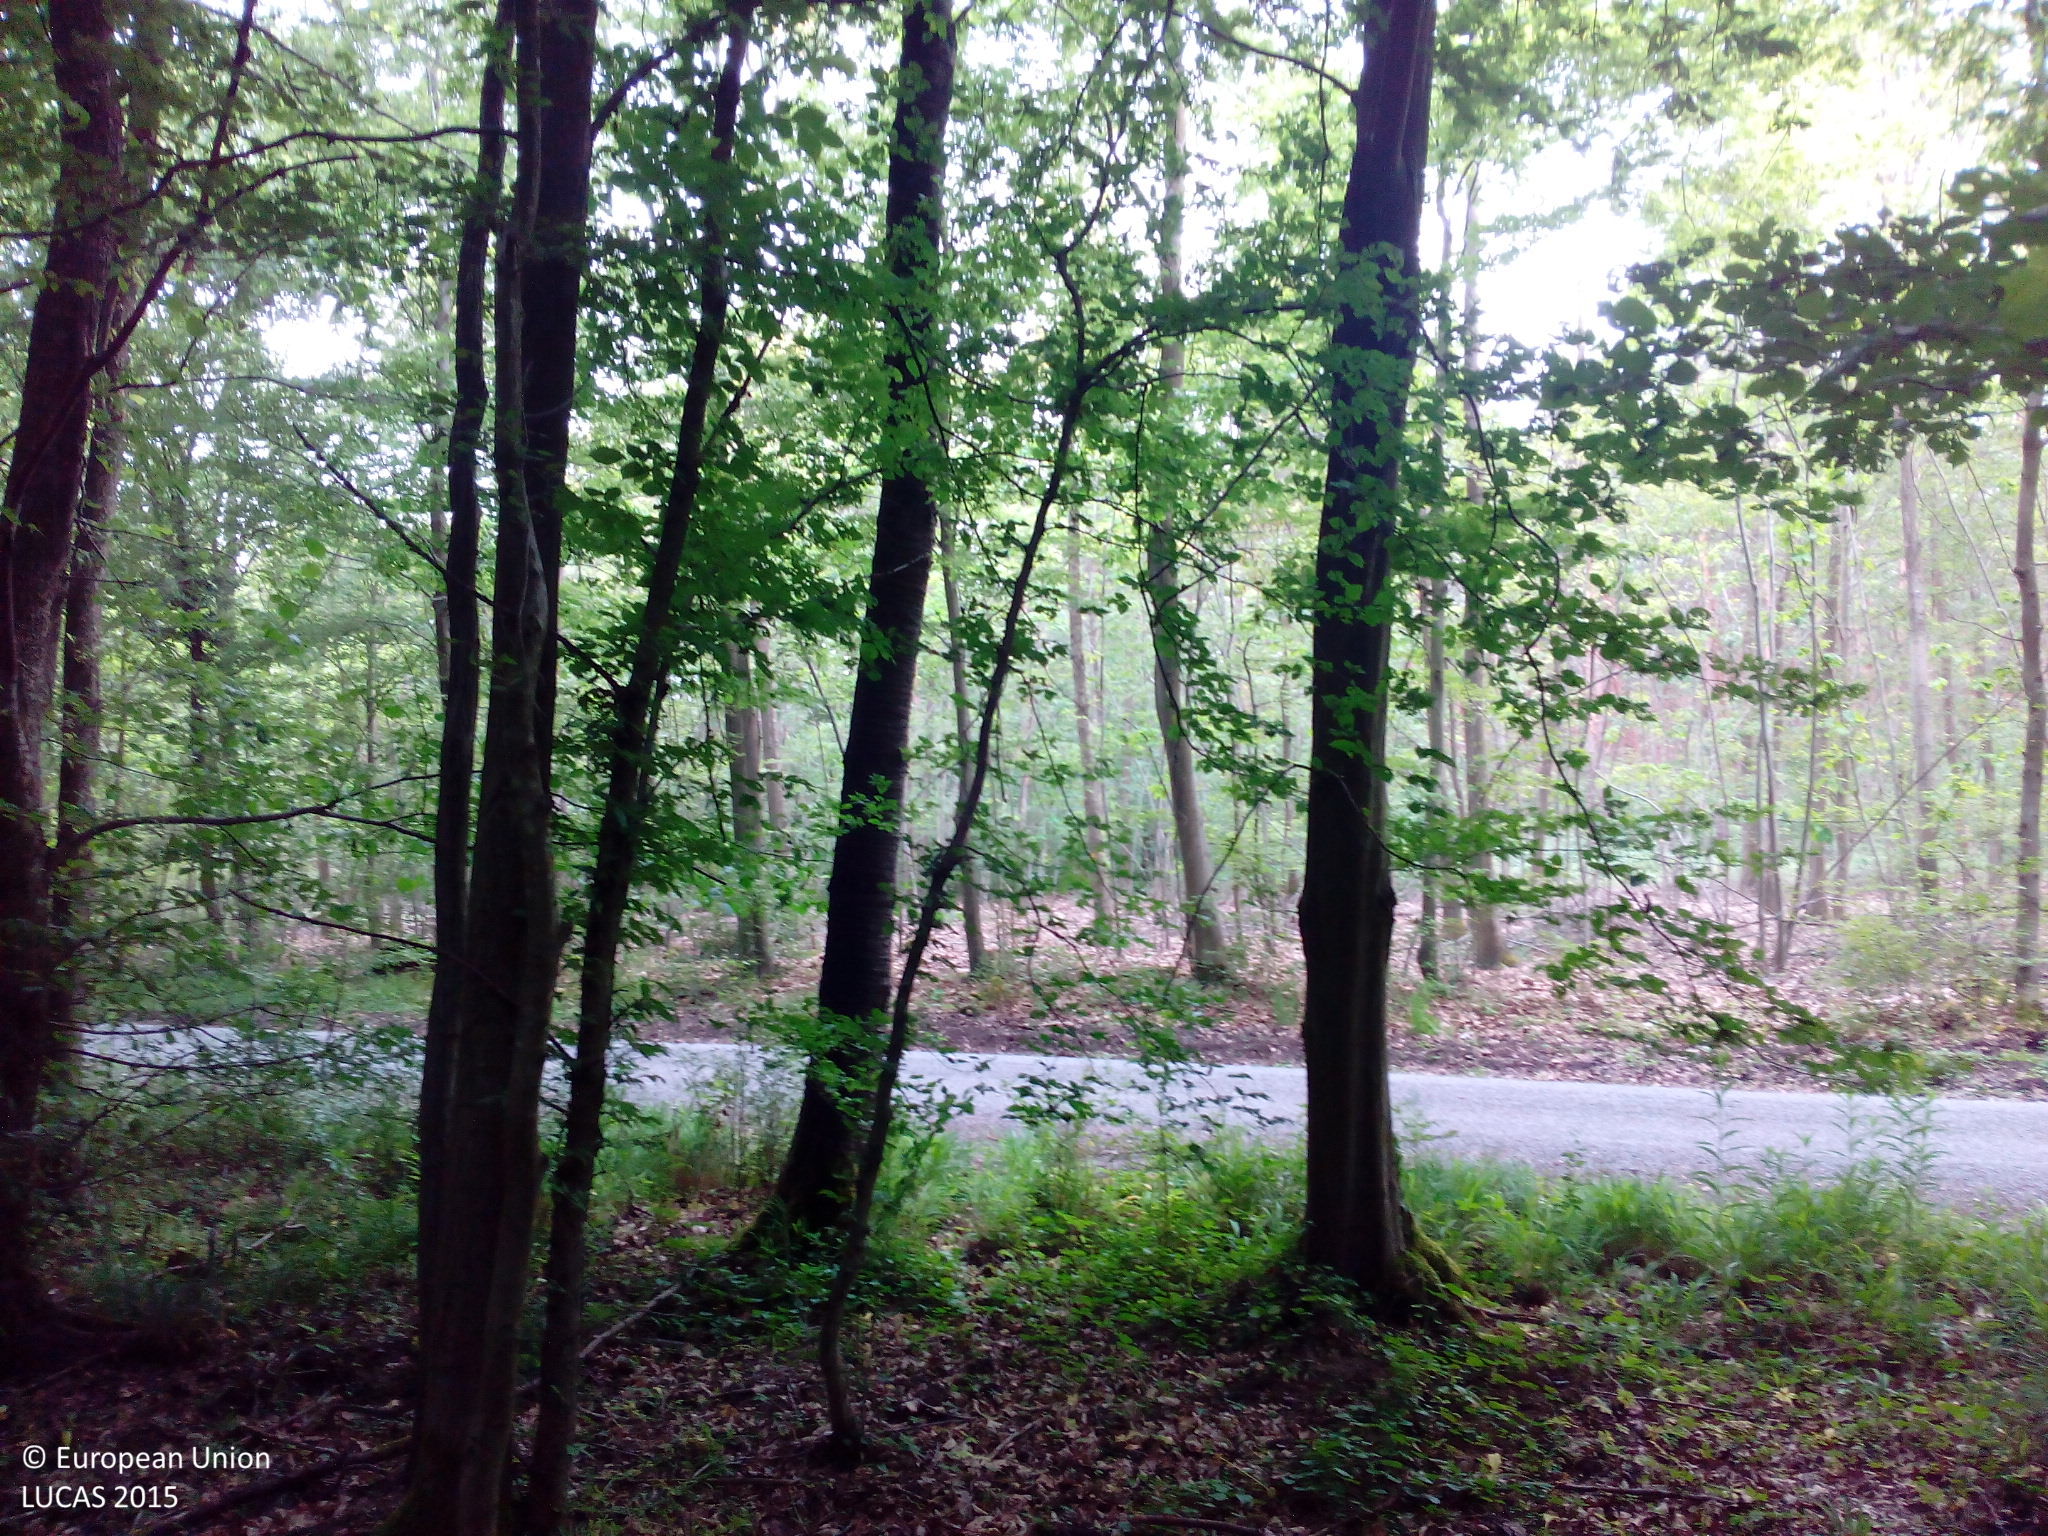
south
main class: Woodland
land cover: Broadleaved woodland
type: beech forest
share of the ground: > 75 %
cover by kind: broadleaved forest trees 90 %, herbaceous plants 5 %, unconsolidated bare surface 5 %
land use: Forestry
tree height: > 5 m
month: June
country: DE
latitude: 49.2218
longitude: 8.5589
